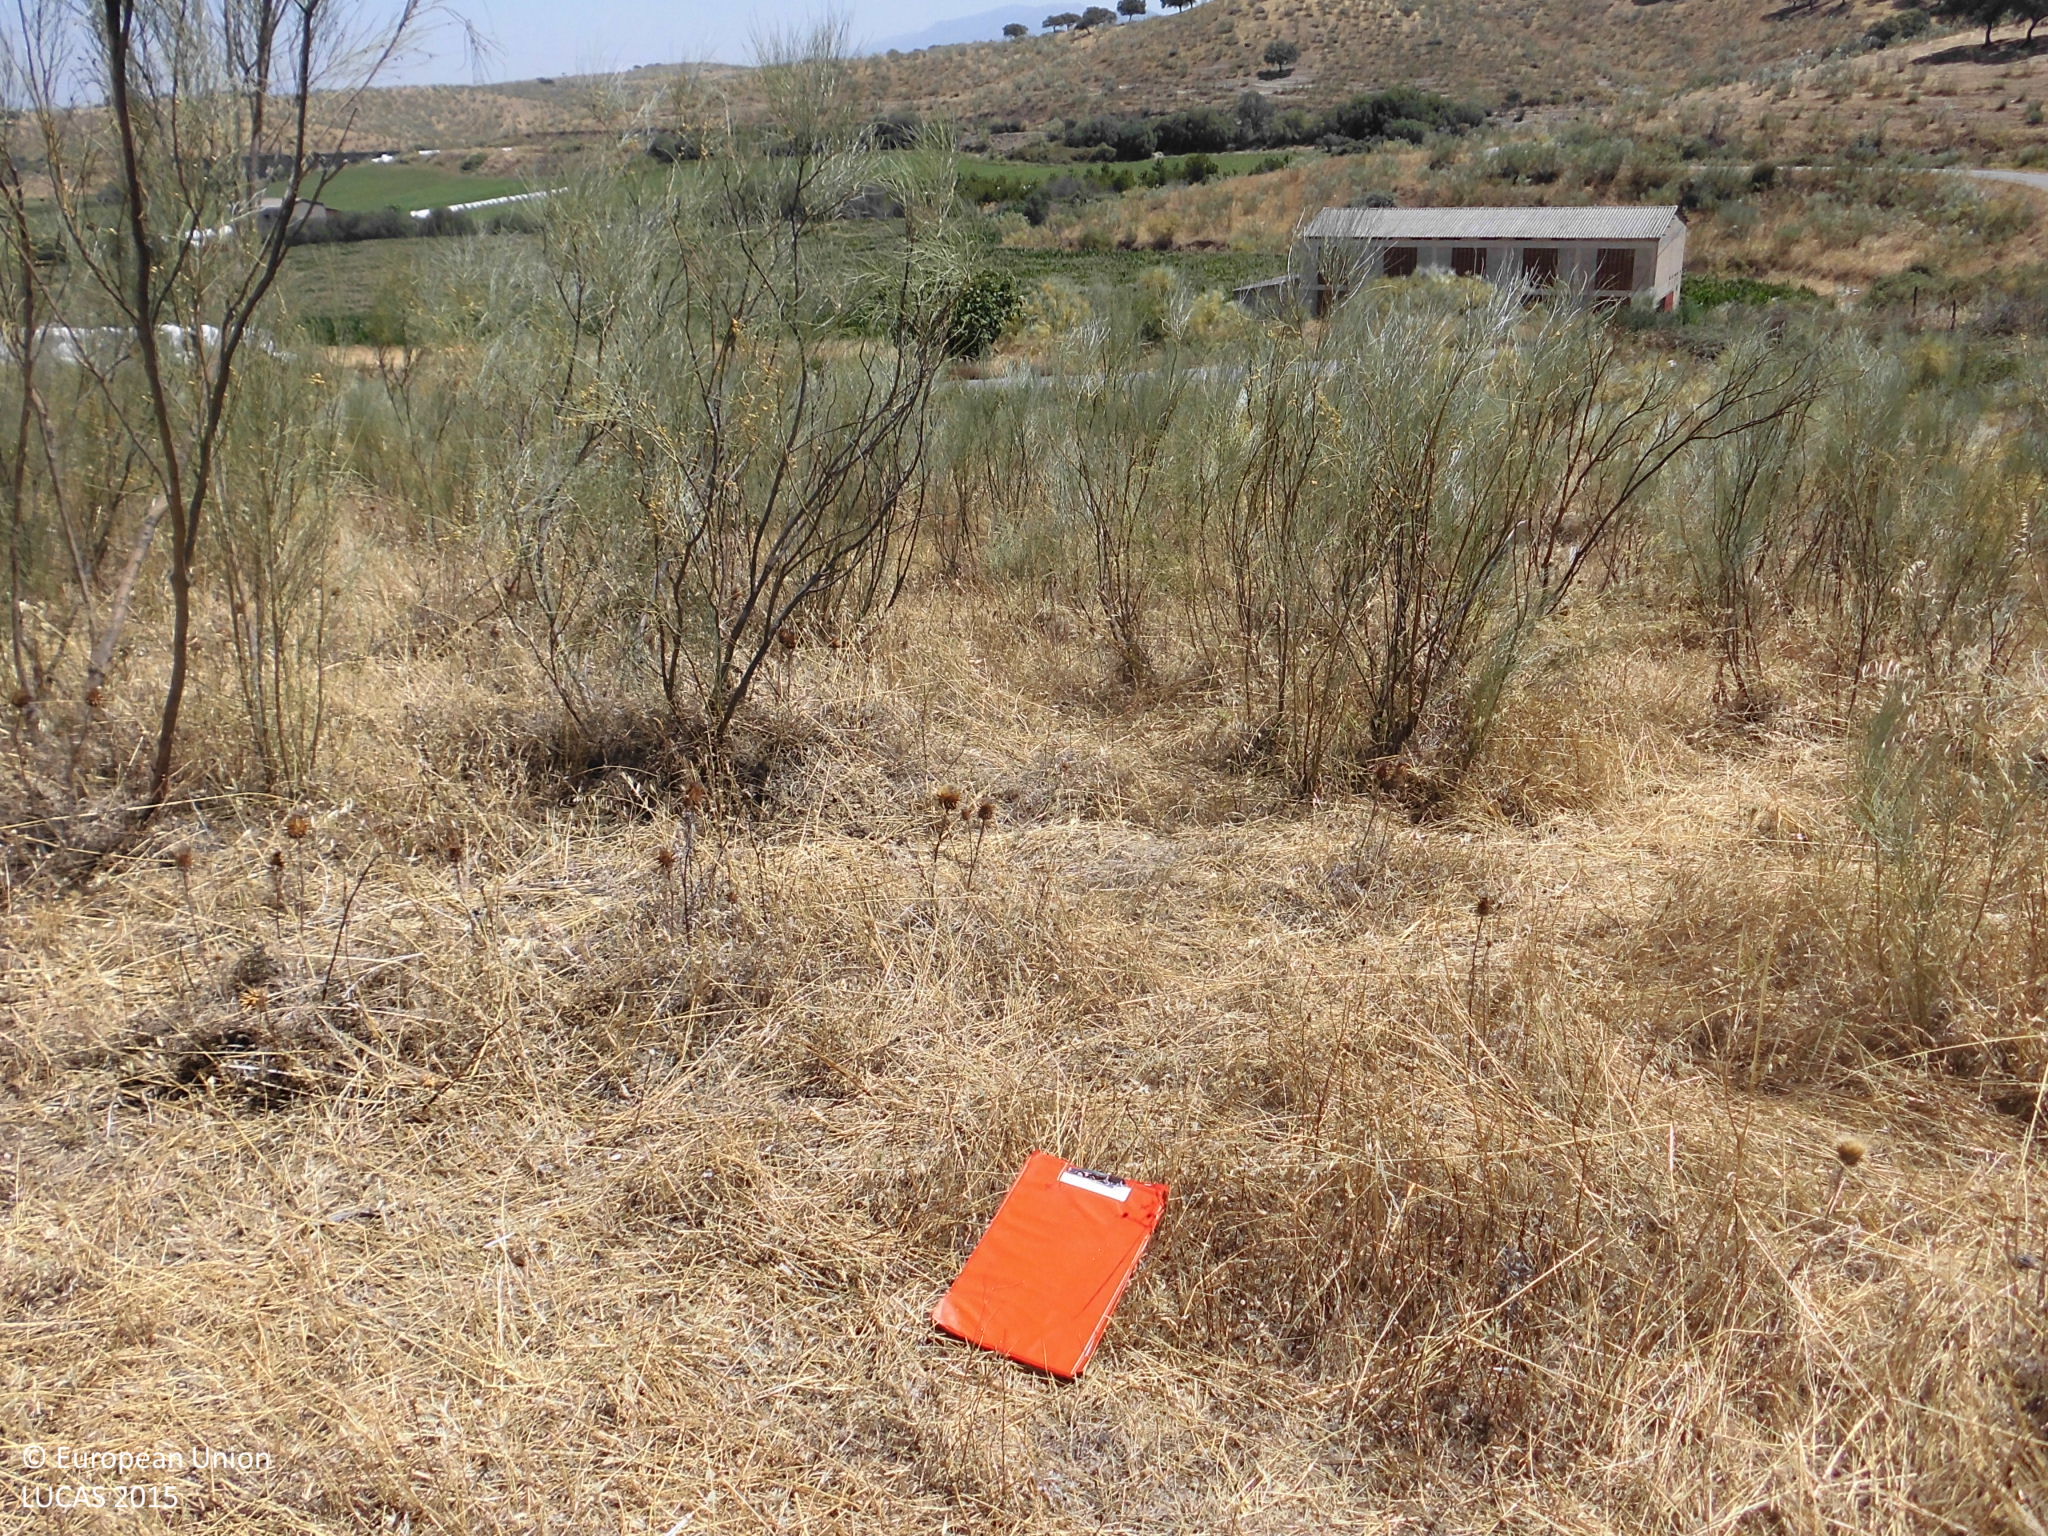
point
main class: Shrubland
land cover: Shrubland without tree cover
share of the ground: 25 - 50 %
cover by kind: herbaceous plants 65 %, shrubs 35 %
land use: Agriculture (excluding fallow land and kitchen gardens)
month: July
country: ES
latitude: 39.9967
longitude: -6.2016
